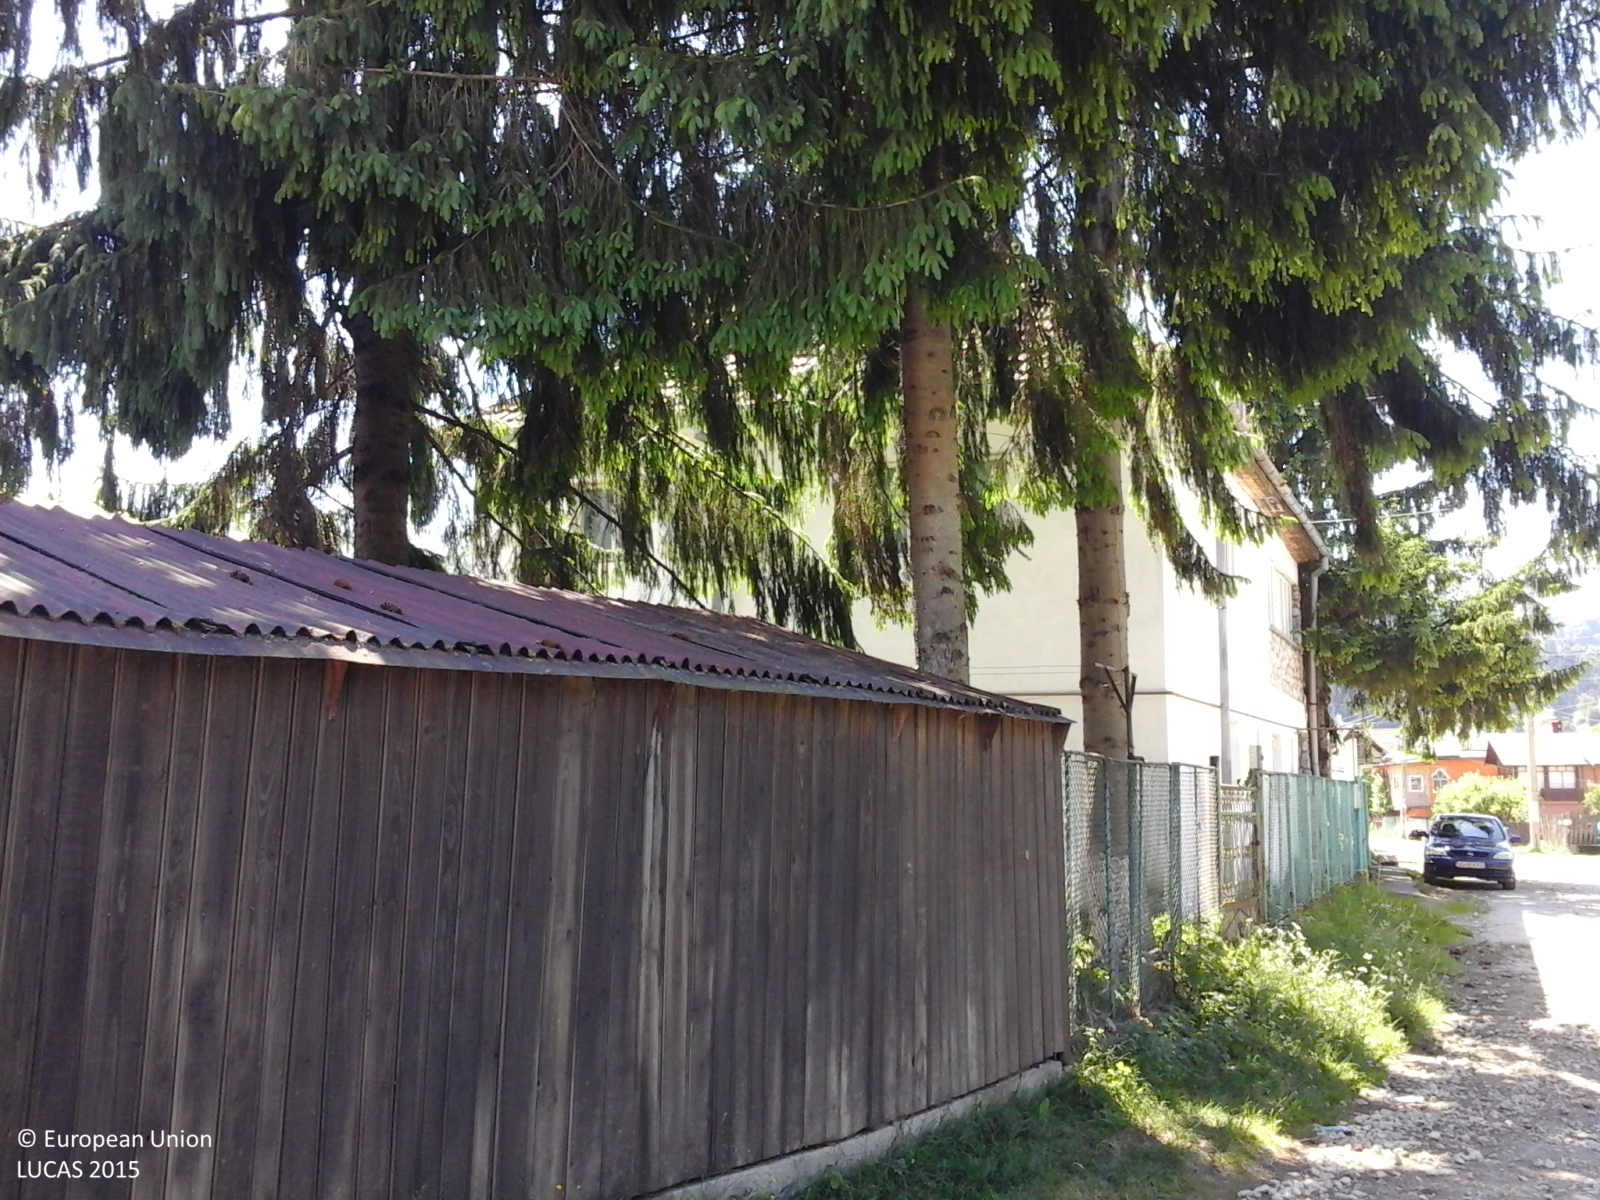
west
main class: Cropland
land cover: Apple fruit
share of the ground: 25 - 50 %
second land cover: Grassland without tree/shrub cover
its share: 50 - 75 %
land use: Agriculture (excluding fallow land and kitchen gardens)
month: June
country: RO
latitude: 45.3885
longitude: 25.1770
